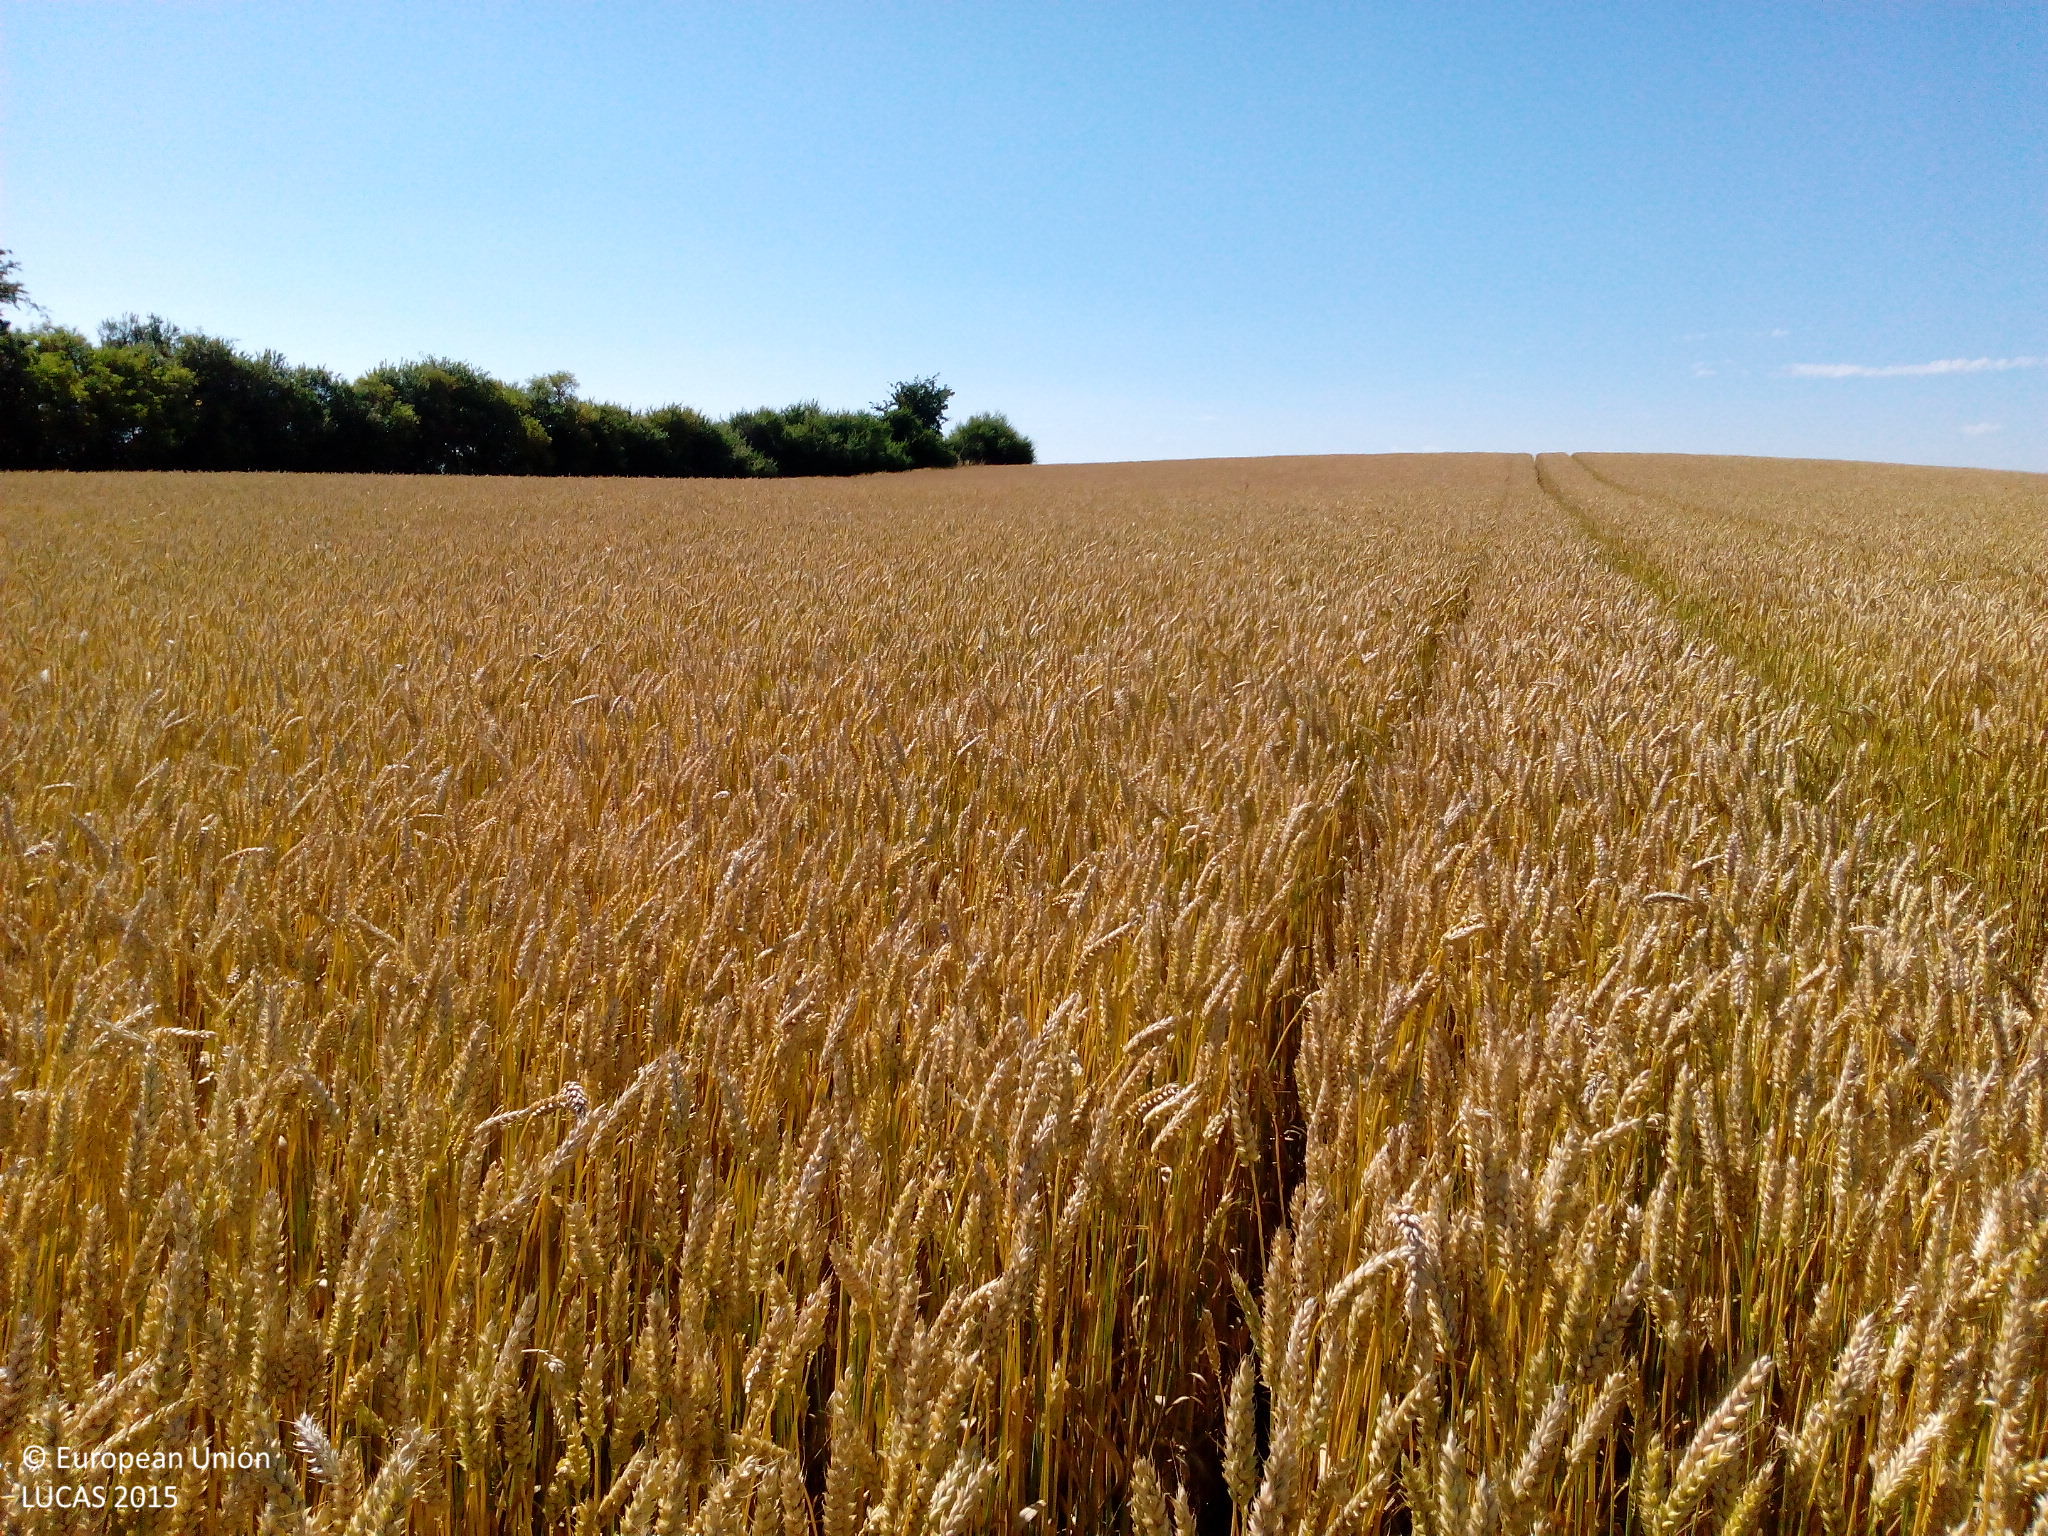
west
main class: Cropland
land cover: Common wheat
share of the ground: > 75 %
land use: Agriculture (excluding fallow land and kitchen gardens)
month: August
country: DK
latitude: 55.6008
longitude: 11.7284
